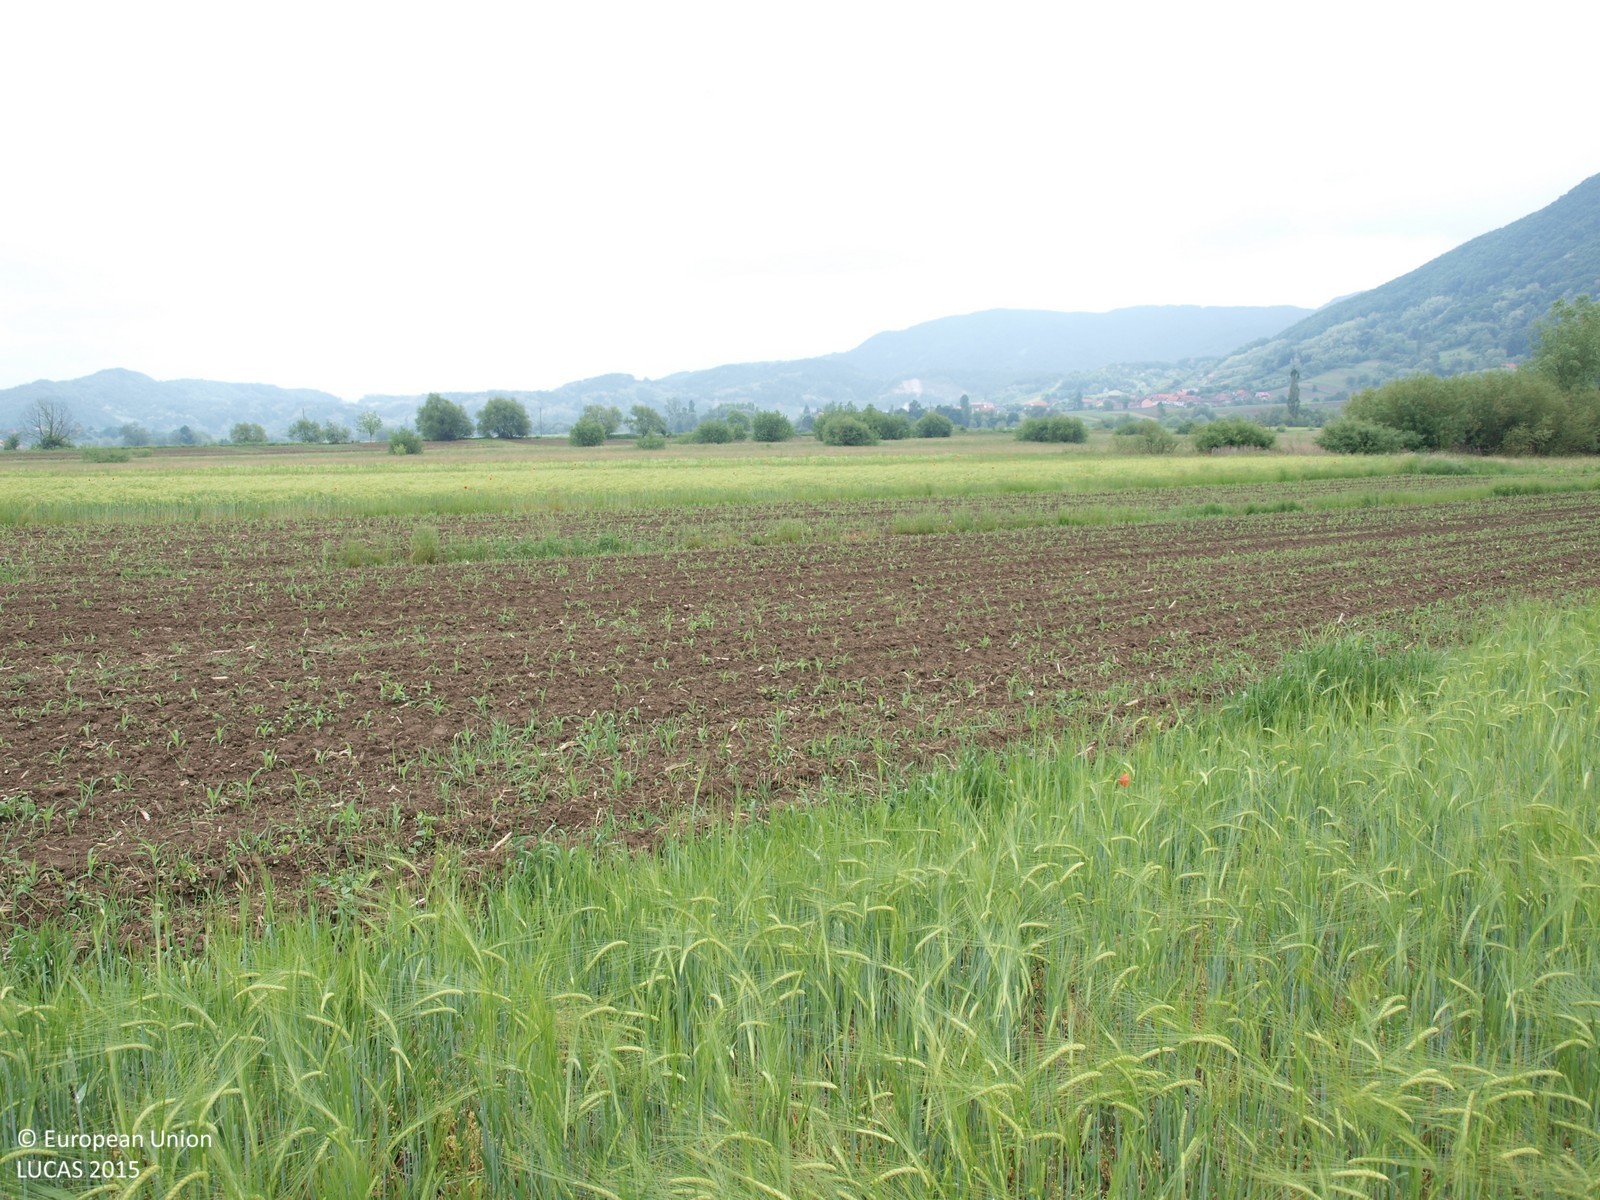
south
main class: Cropland
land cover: Barley
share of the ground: > 75 %
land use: Agriculture (excluding fallow land and kitchen gardens)
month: May
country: HR
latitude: 46.2204
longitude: 16.2873
